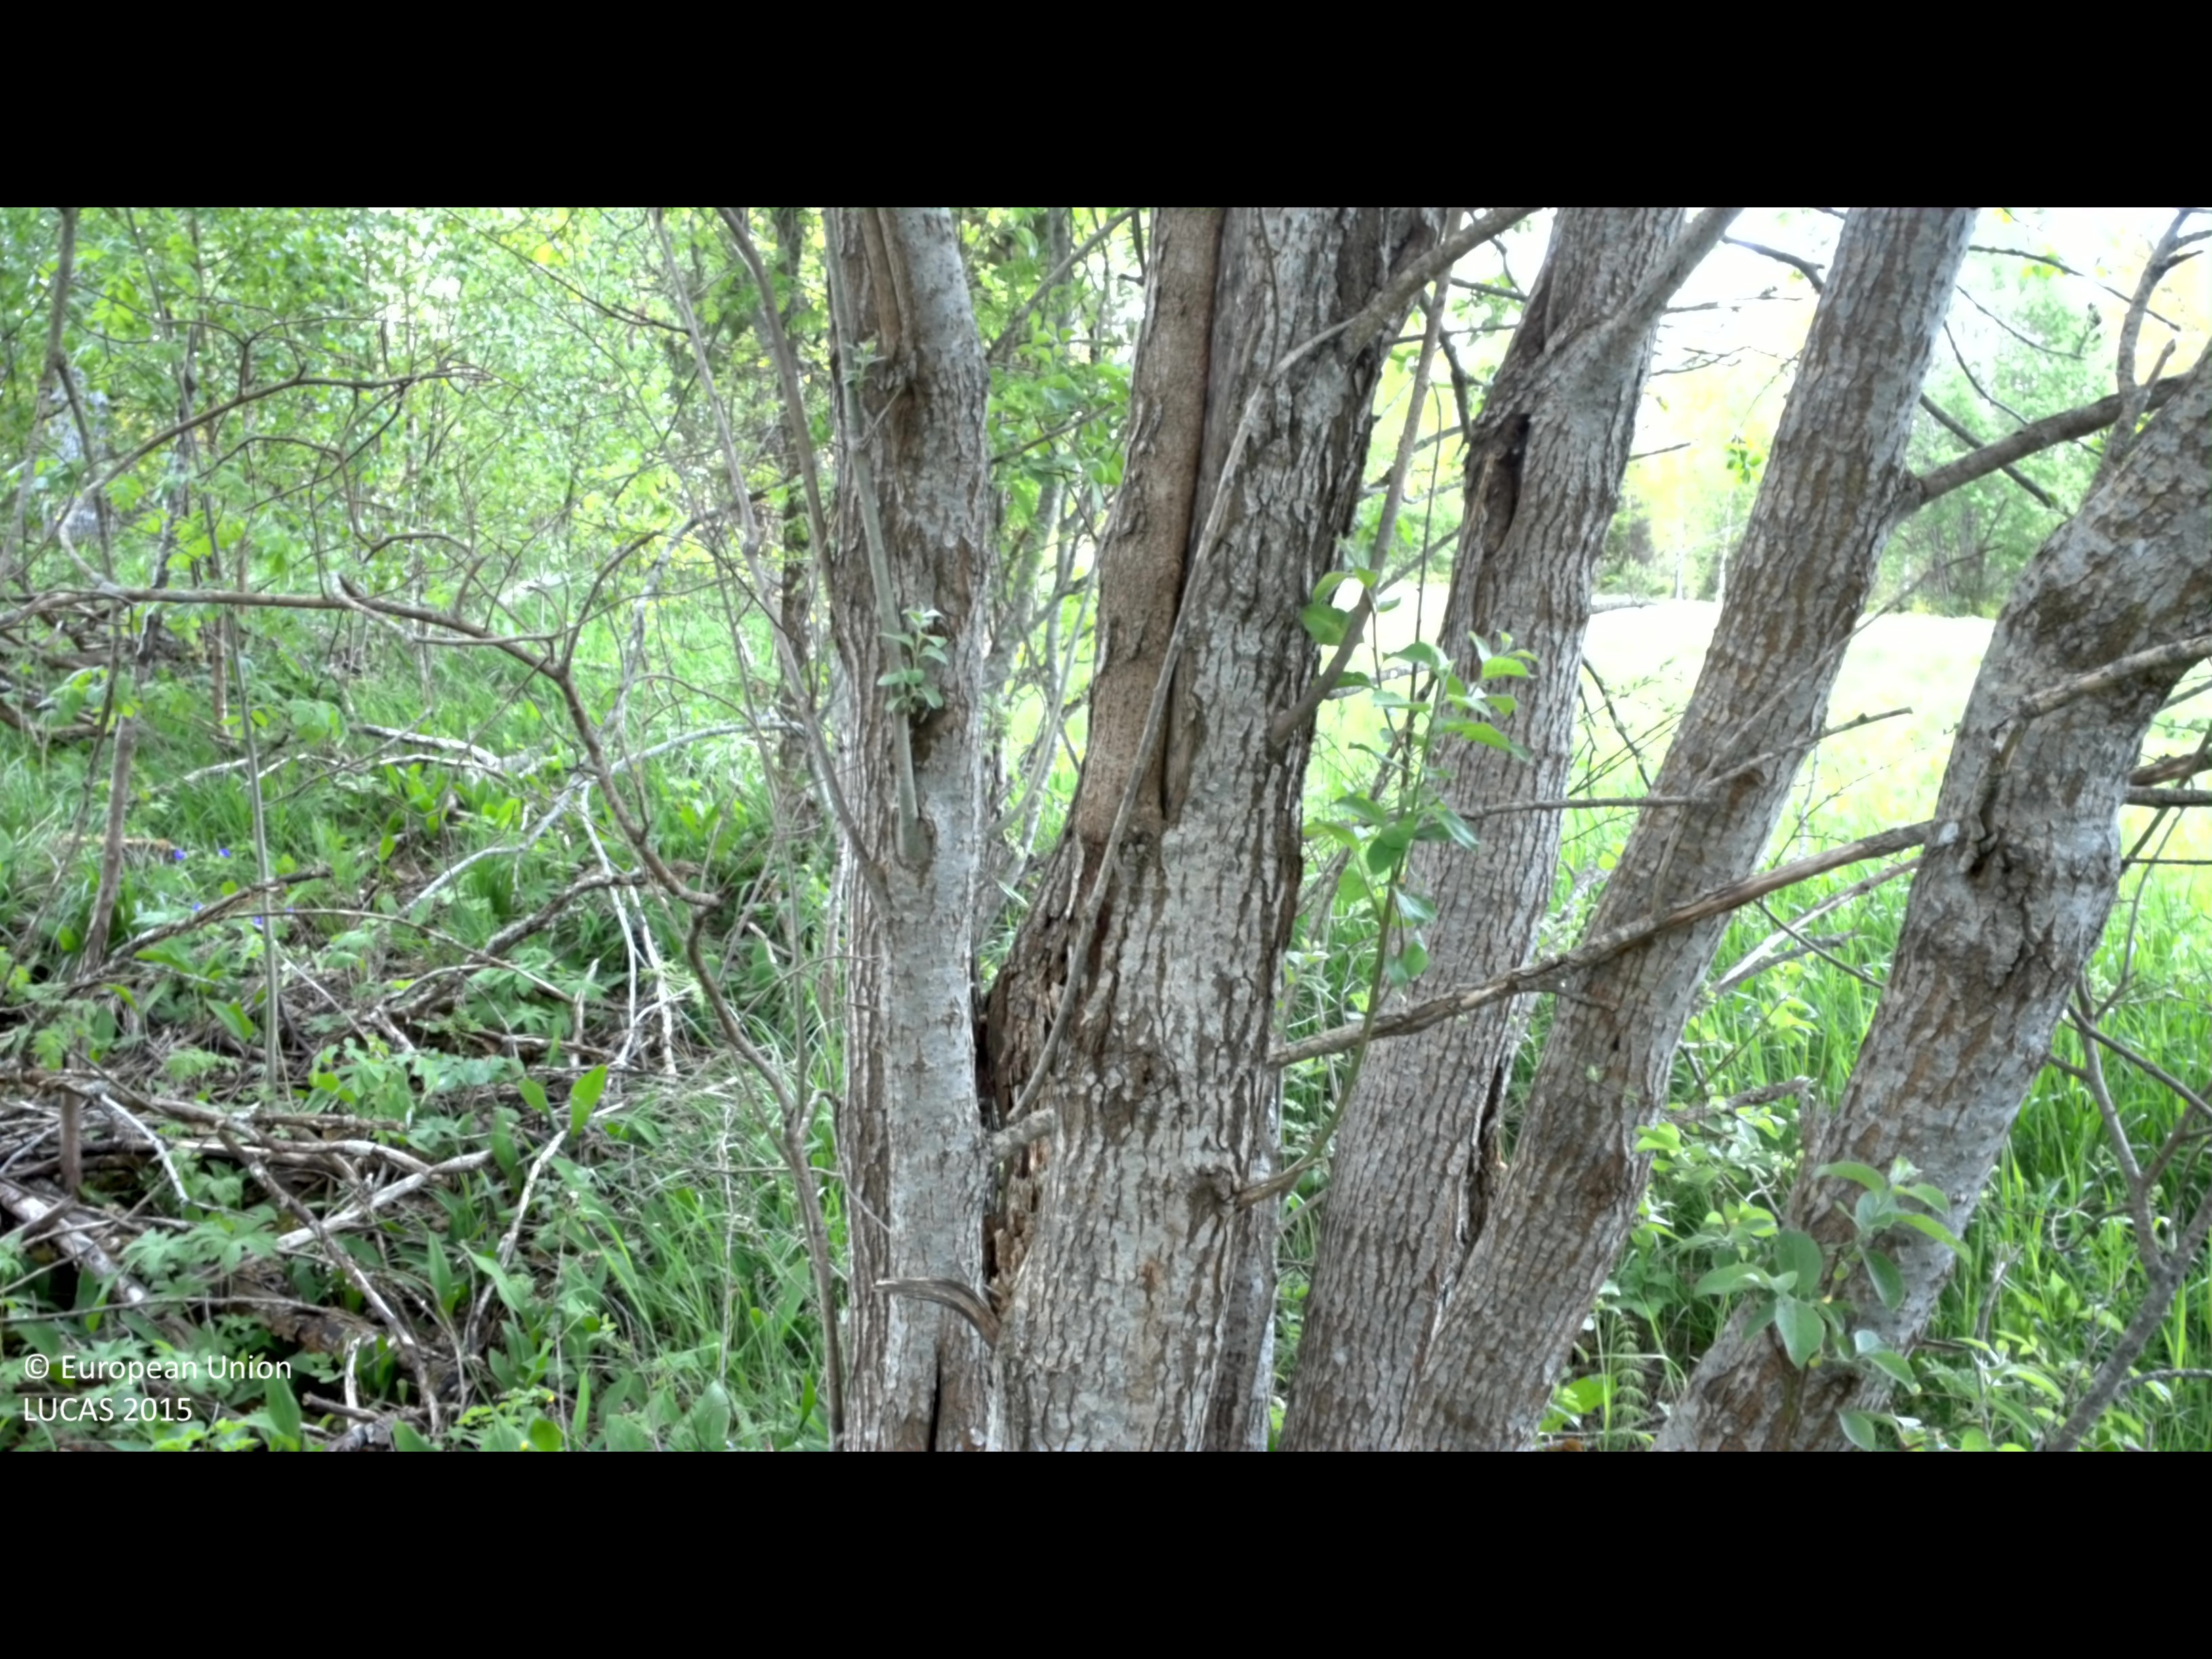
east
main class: Woodland
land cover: Broadleaved woodland
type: hemiboreal forest and nemoral coniferous forest and mixed broadleaved-coniferous forest
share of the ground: 50 - 75 %
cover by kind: broadleaved forest trees 50 %, herbaceous plants 25 %, shrubs 15 %, coniferous forest trees 5 %
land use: Forestry
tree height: > 5 m
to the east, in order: Broadleaved woodland; Other leguminous and mixtures for fodder; Pine dominated mixed woodland; Other mixed woodland; Paved roads, cycling and walking lanes; Spruce dominated mixed woodland; Shrubland with sparse tree cover; Pine dominated coniferous woodland
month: June
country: SE
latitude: 57.6801
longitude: 16.1859
